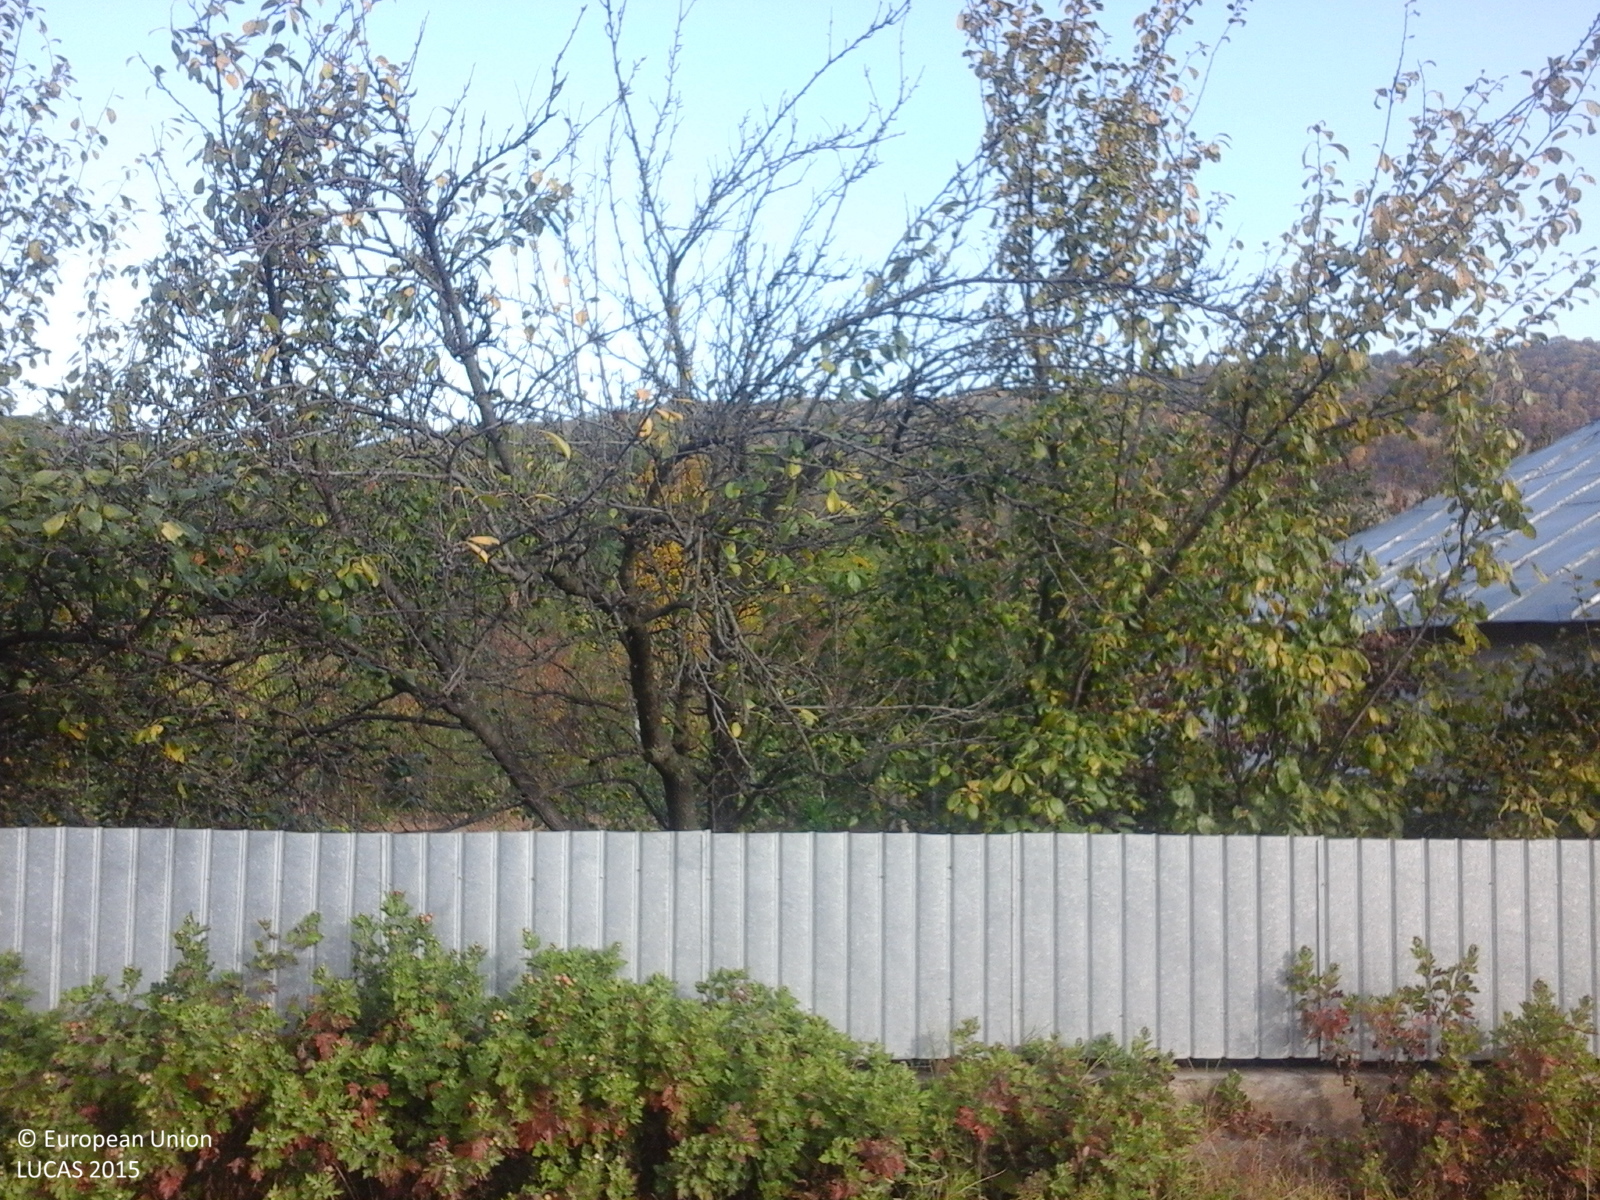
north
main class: Cropland
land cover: Other fresh vegetables
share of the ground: > 75 %
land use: Kitchen garden
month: October
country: RO
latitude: 45.7643
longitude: 27.0247
